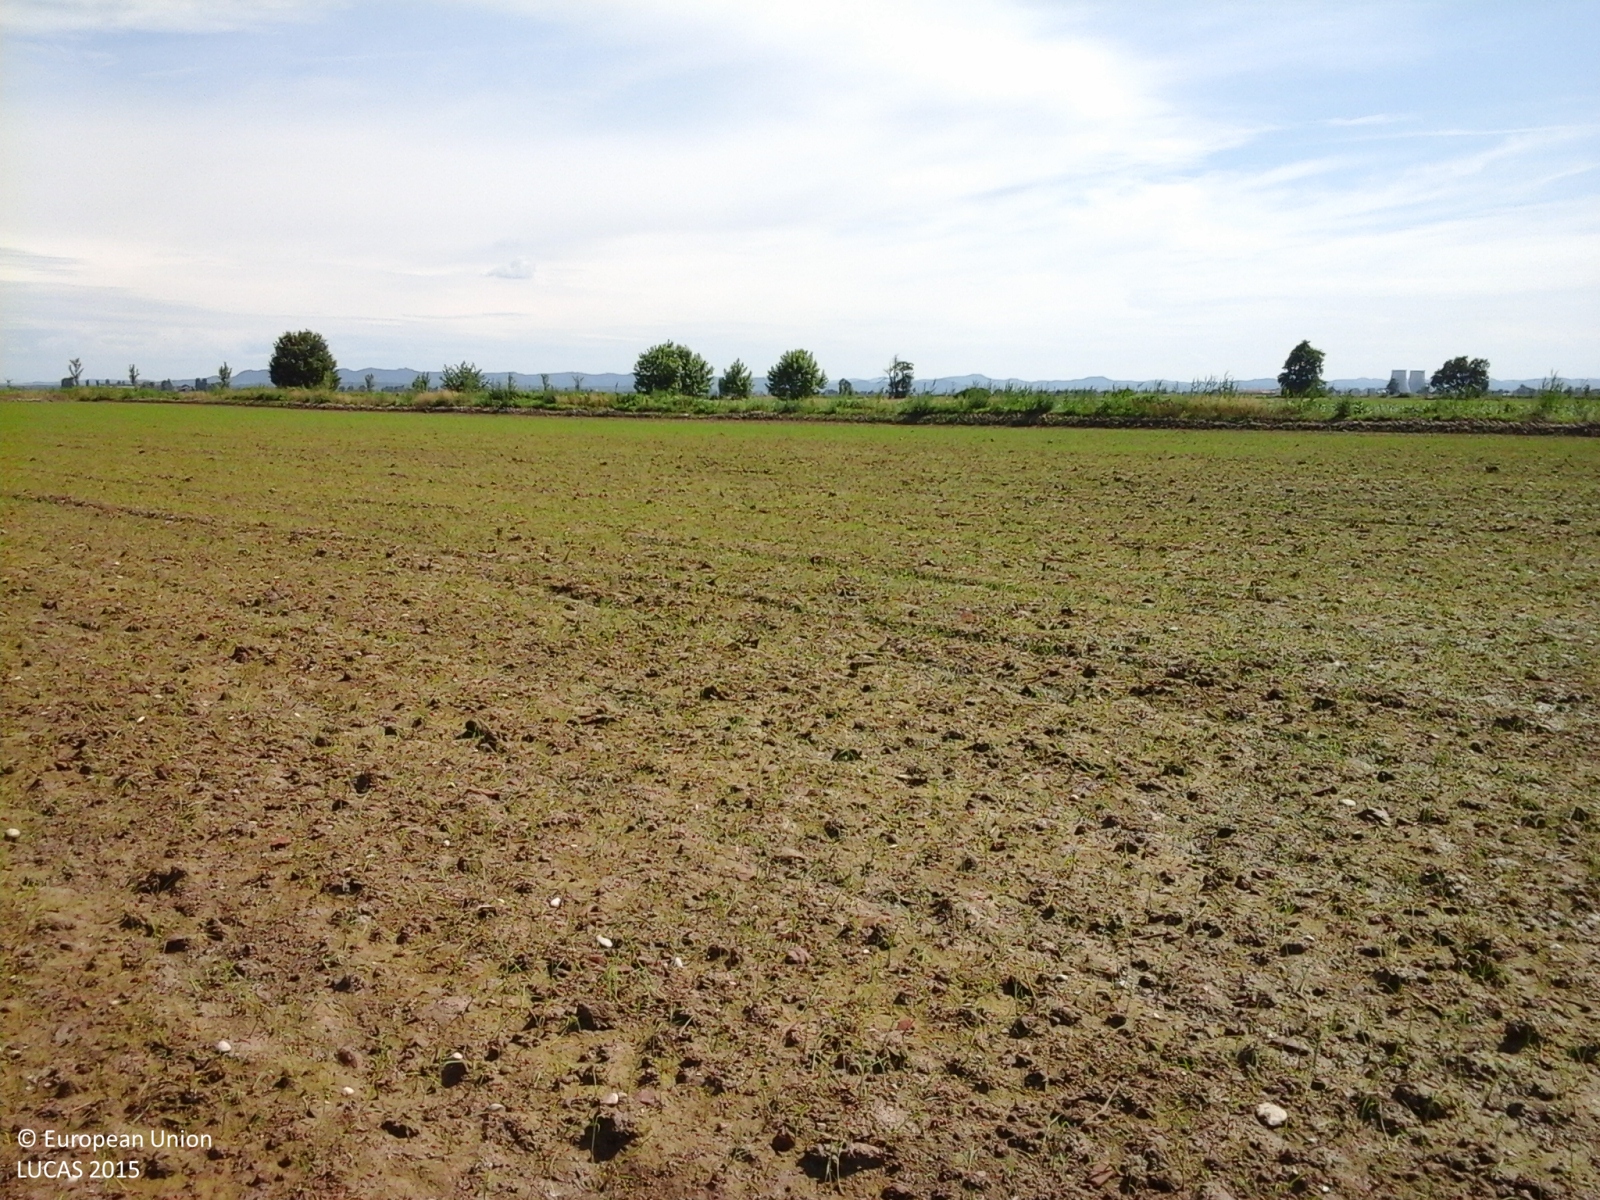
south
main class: Cropland
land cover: Rice
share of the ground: < 10 %
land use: Agriculture (excluding fallow land and kitchen gardens)
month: May
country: IT
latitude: 45.3093
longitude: 8.2301
